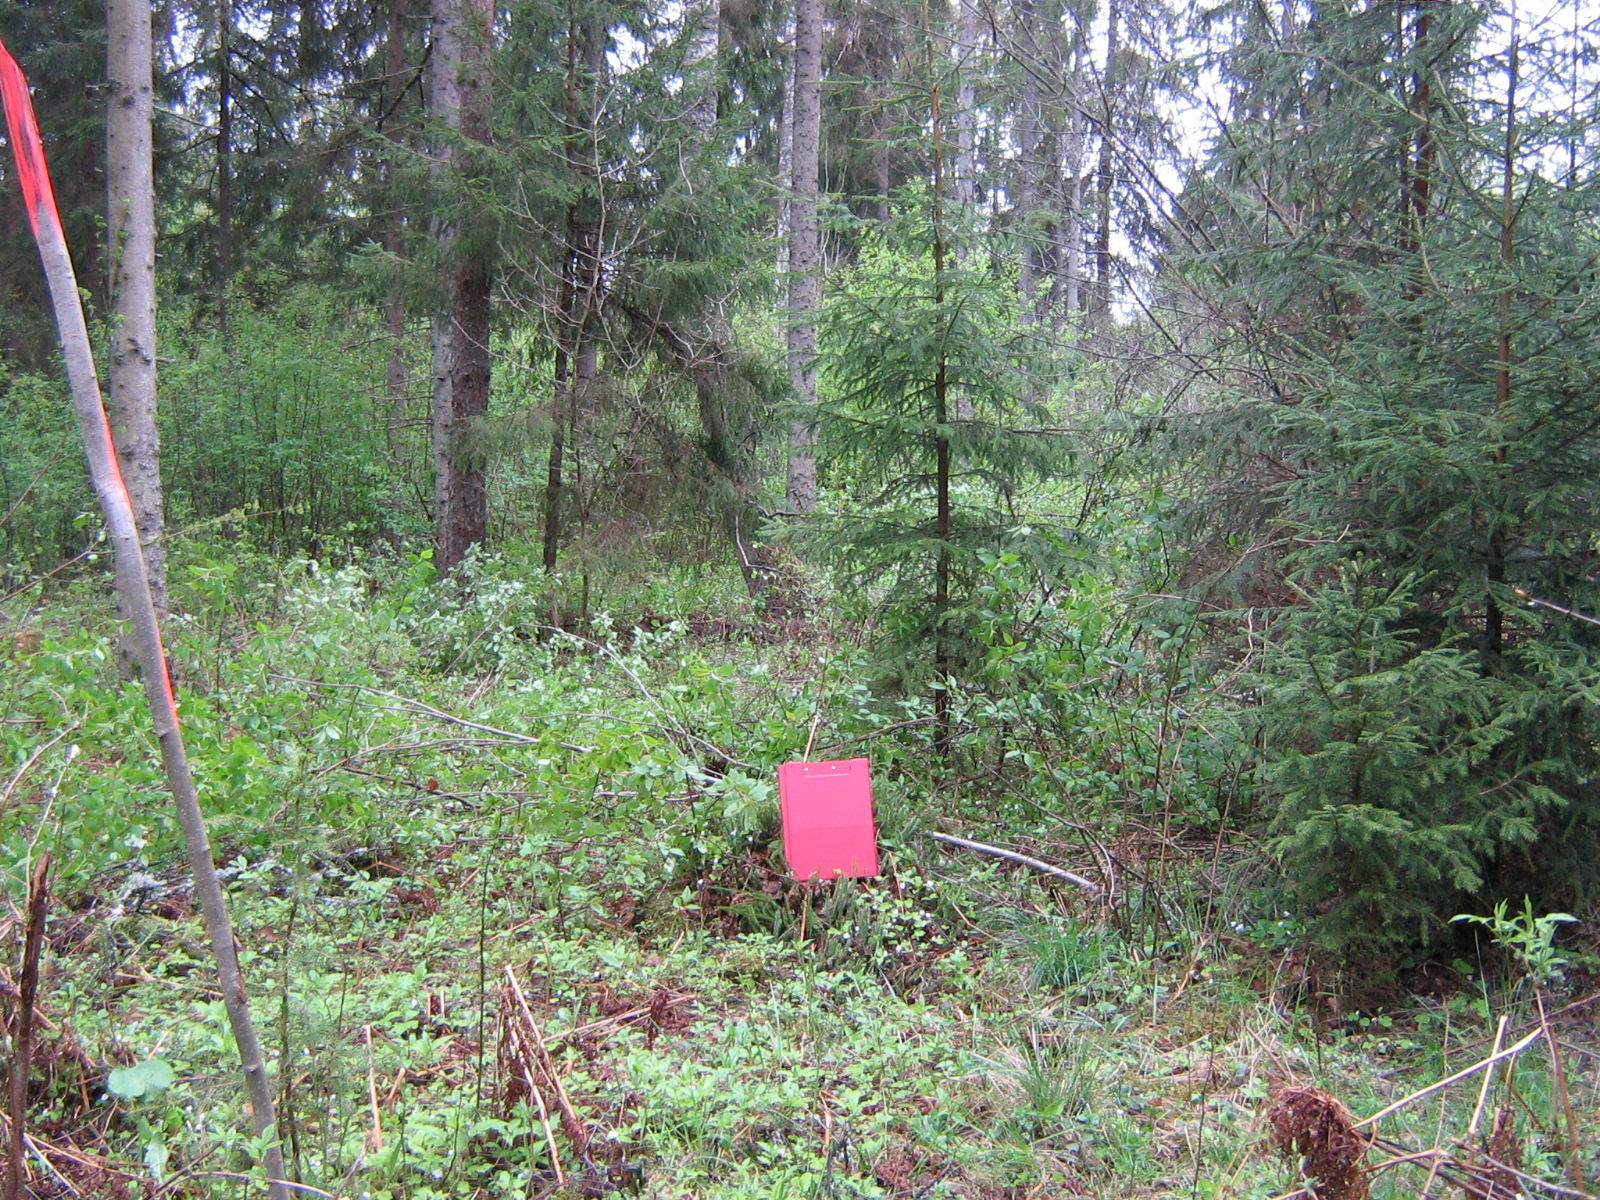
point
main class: Woodland
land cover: Spruce dominated mixed woodland
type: hemiboreal forest and nemoral coniferous forest and mixed broadleaved-coniferous forest
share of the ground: > 75 %
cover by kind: coniferous forest trees 60 %, broadleaved forest trees 25 %, shrubs 15 %
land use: Forestry
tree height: > 5 m
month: May
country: LV
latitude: 57.2042
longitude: 25.3249
